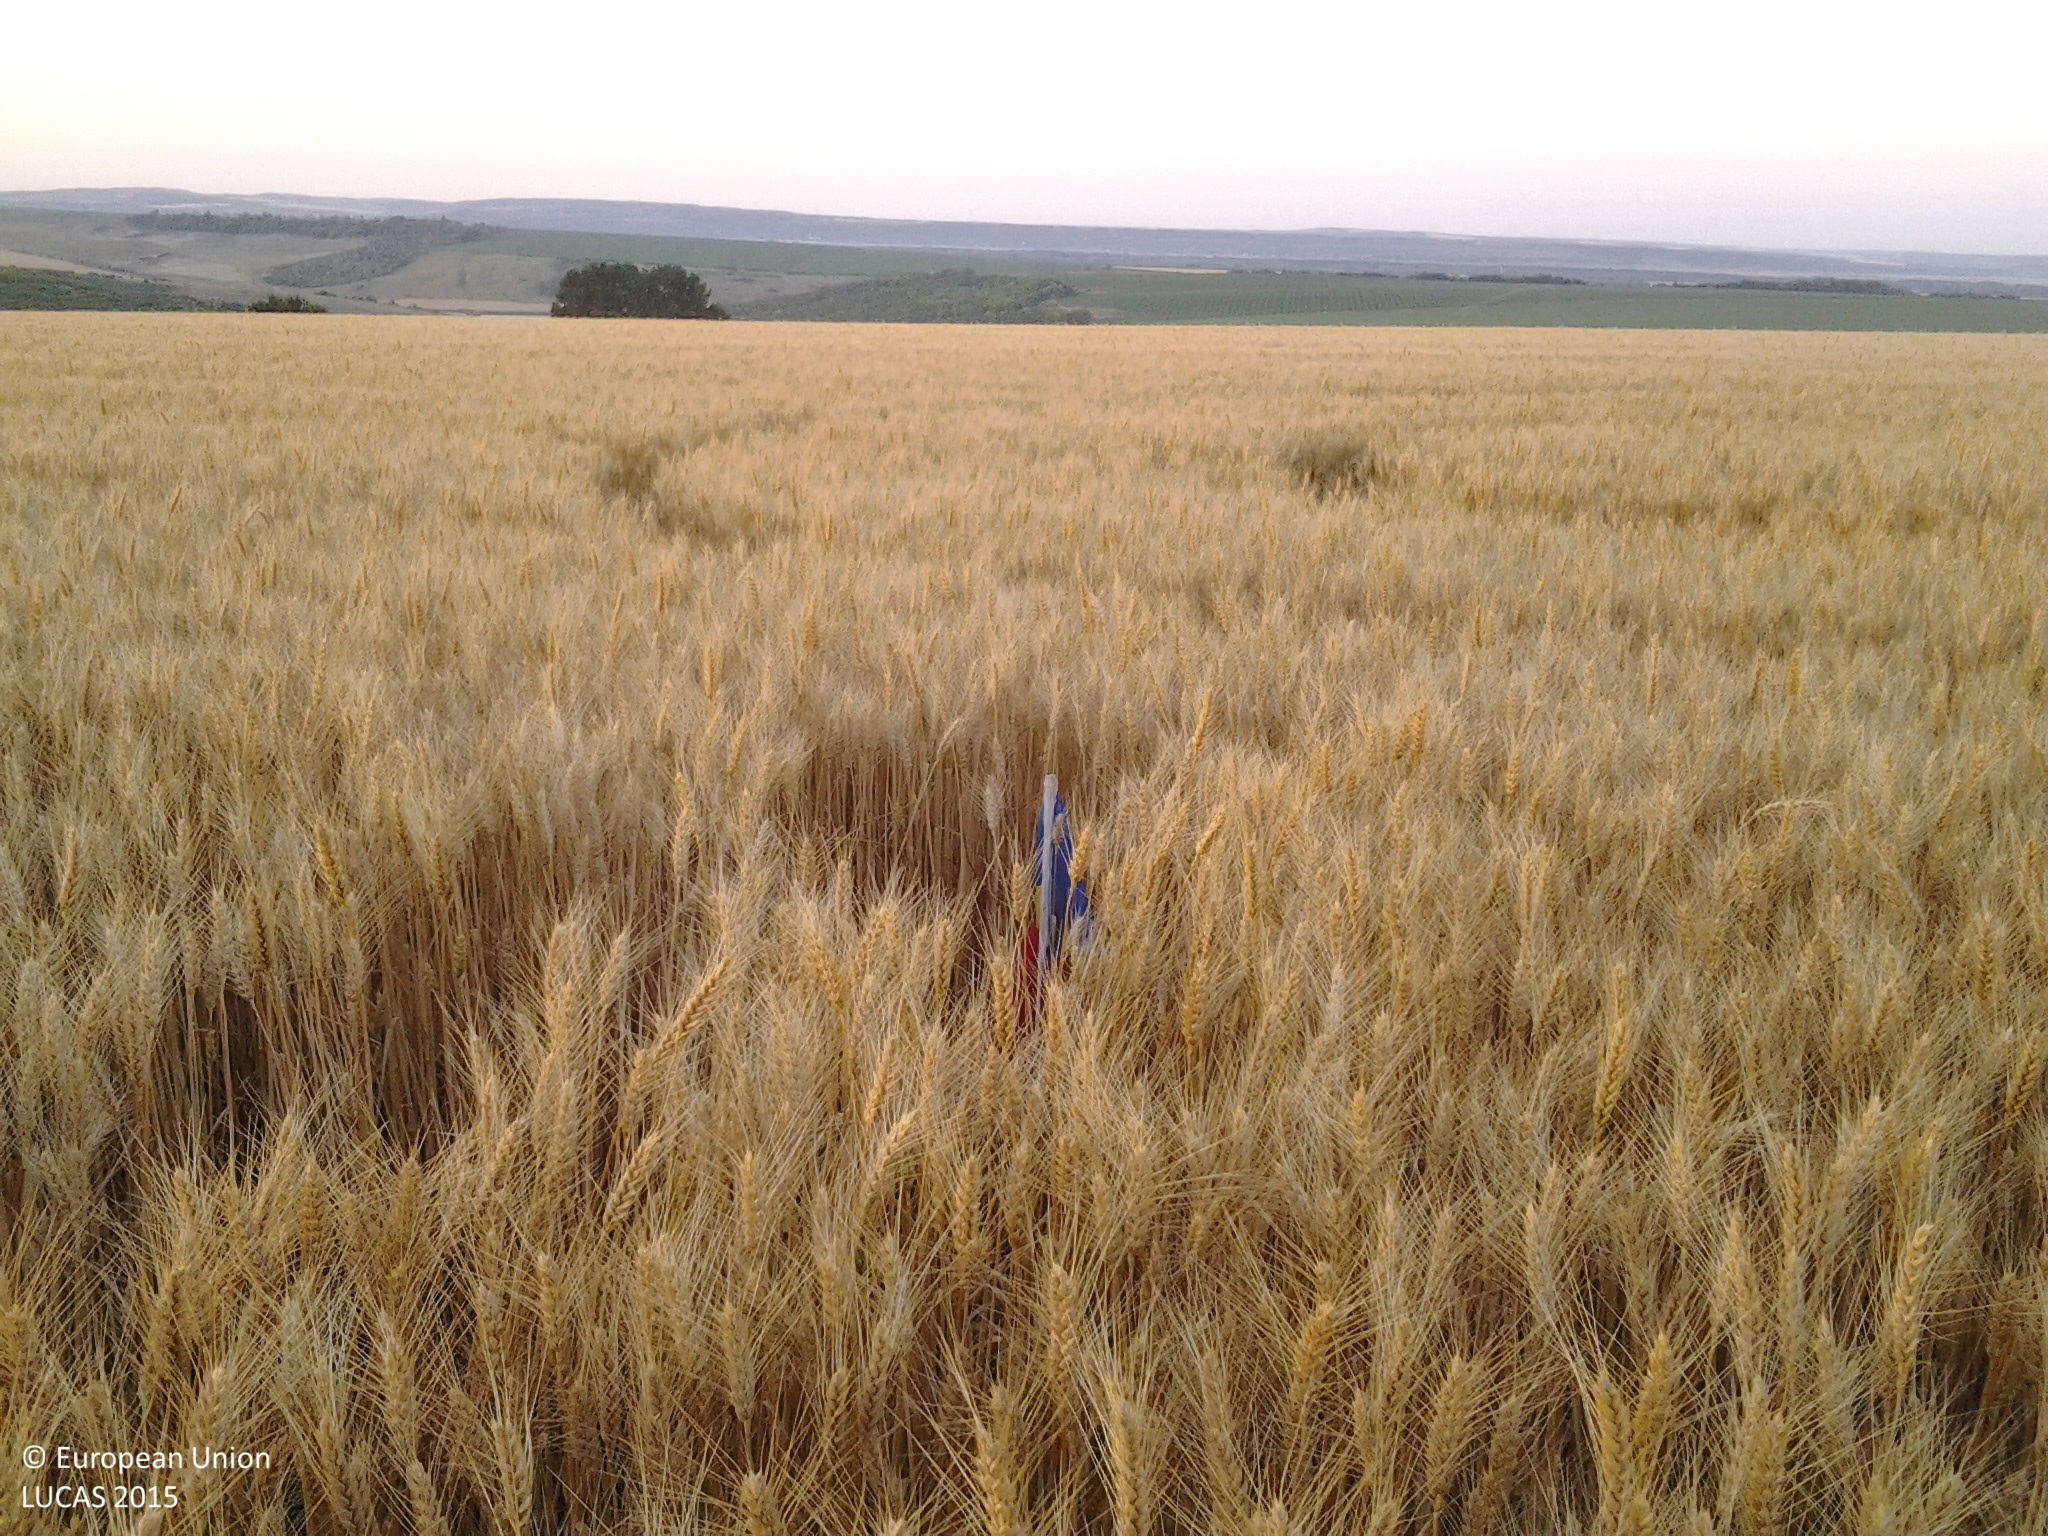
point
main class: Cropland
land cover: Common wheat
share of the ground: > 75 %
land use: Agriculture (excluding fallow land and kitchen gardens)
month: June
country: RO
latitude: 47.4908
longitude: 27.3826
